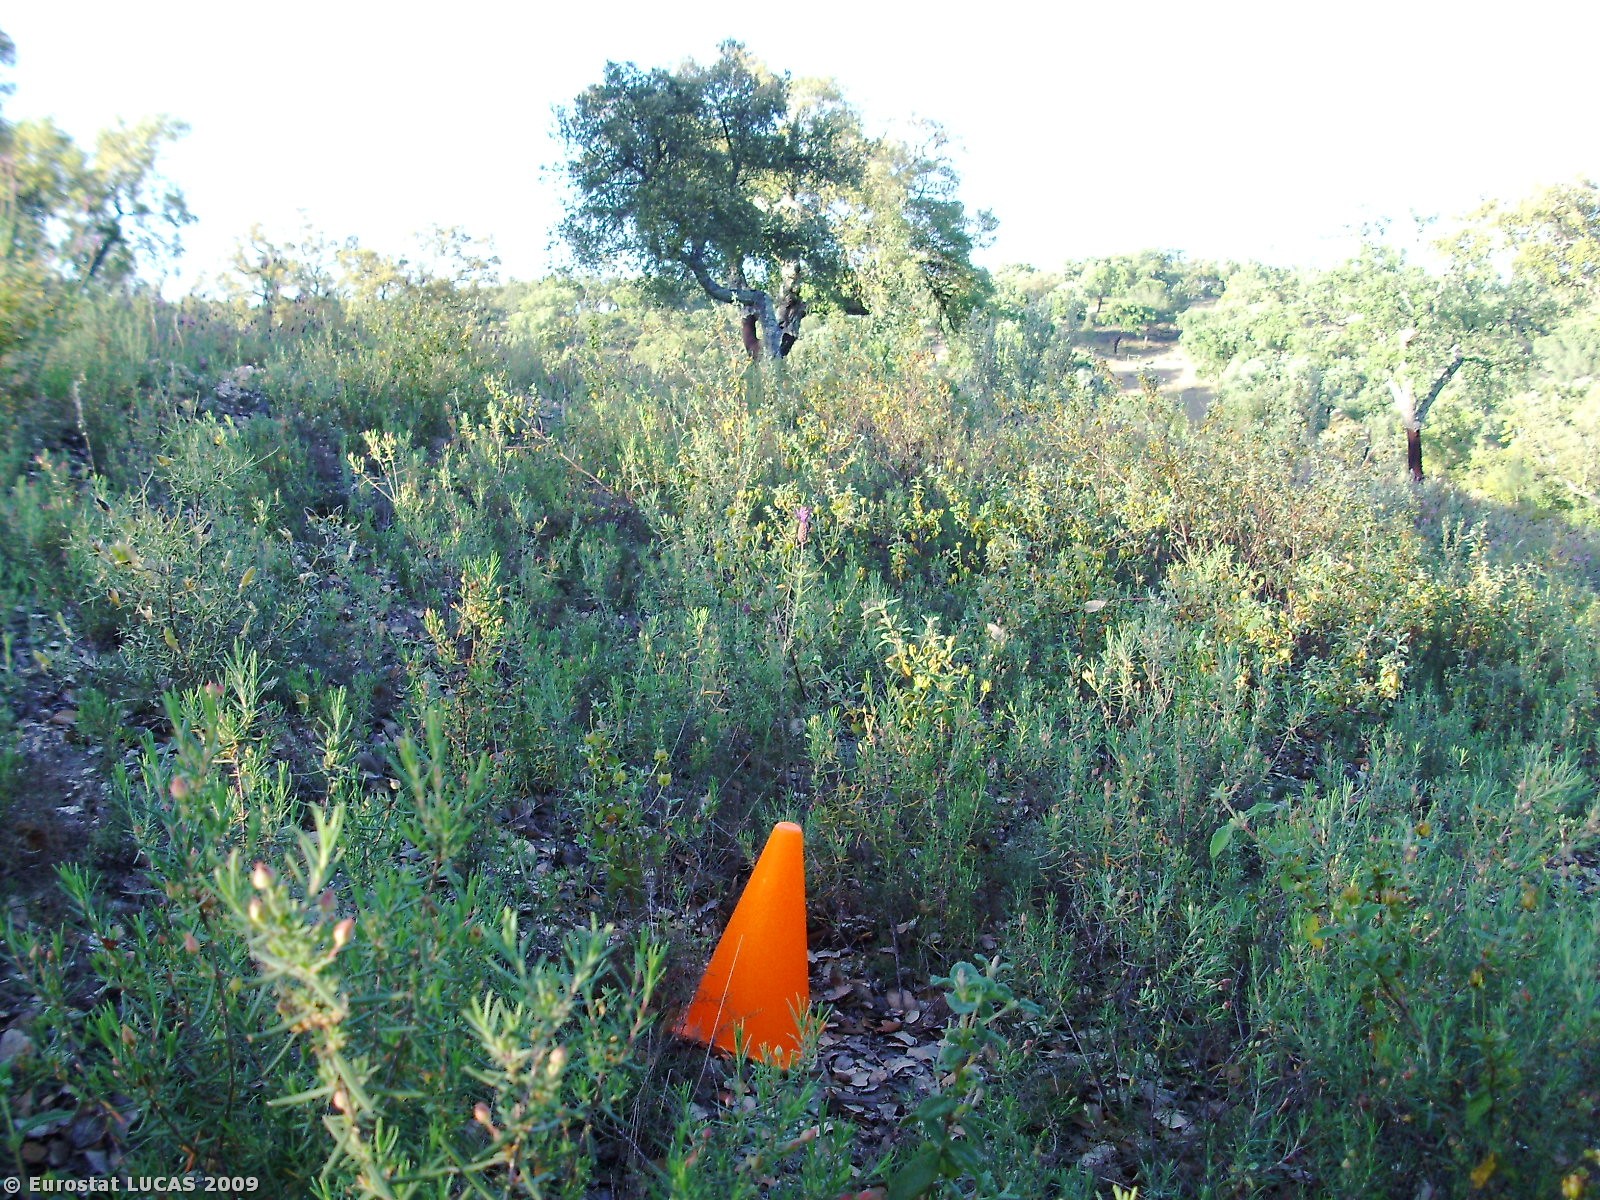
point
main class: Woodland
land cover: Broadleaved woodland
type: broadleaved evergreen forest
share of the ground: 25 - 50 %
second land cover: Spontaneously vegetated surfaces
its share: 50 - 75 %
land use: Forestry
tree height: > 5 m
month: May
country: PT
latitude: 39.1989
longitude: -7.9895
